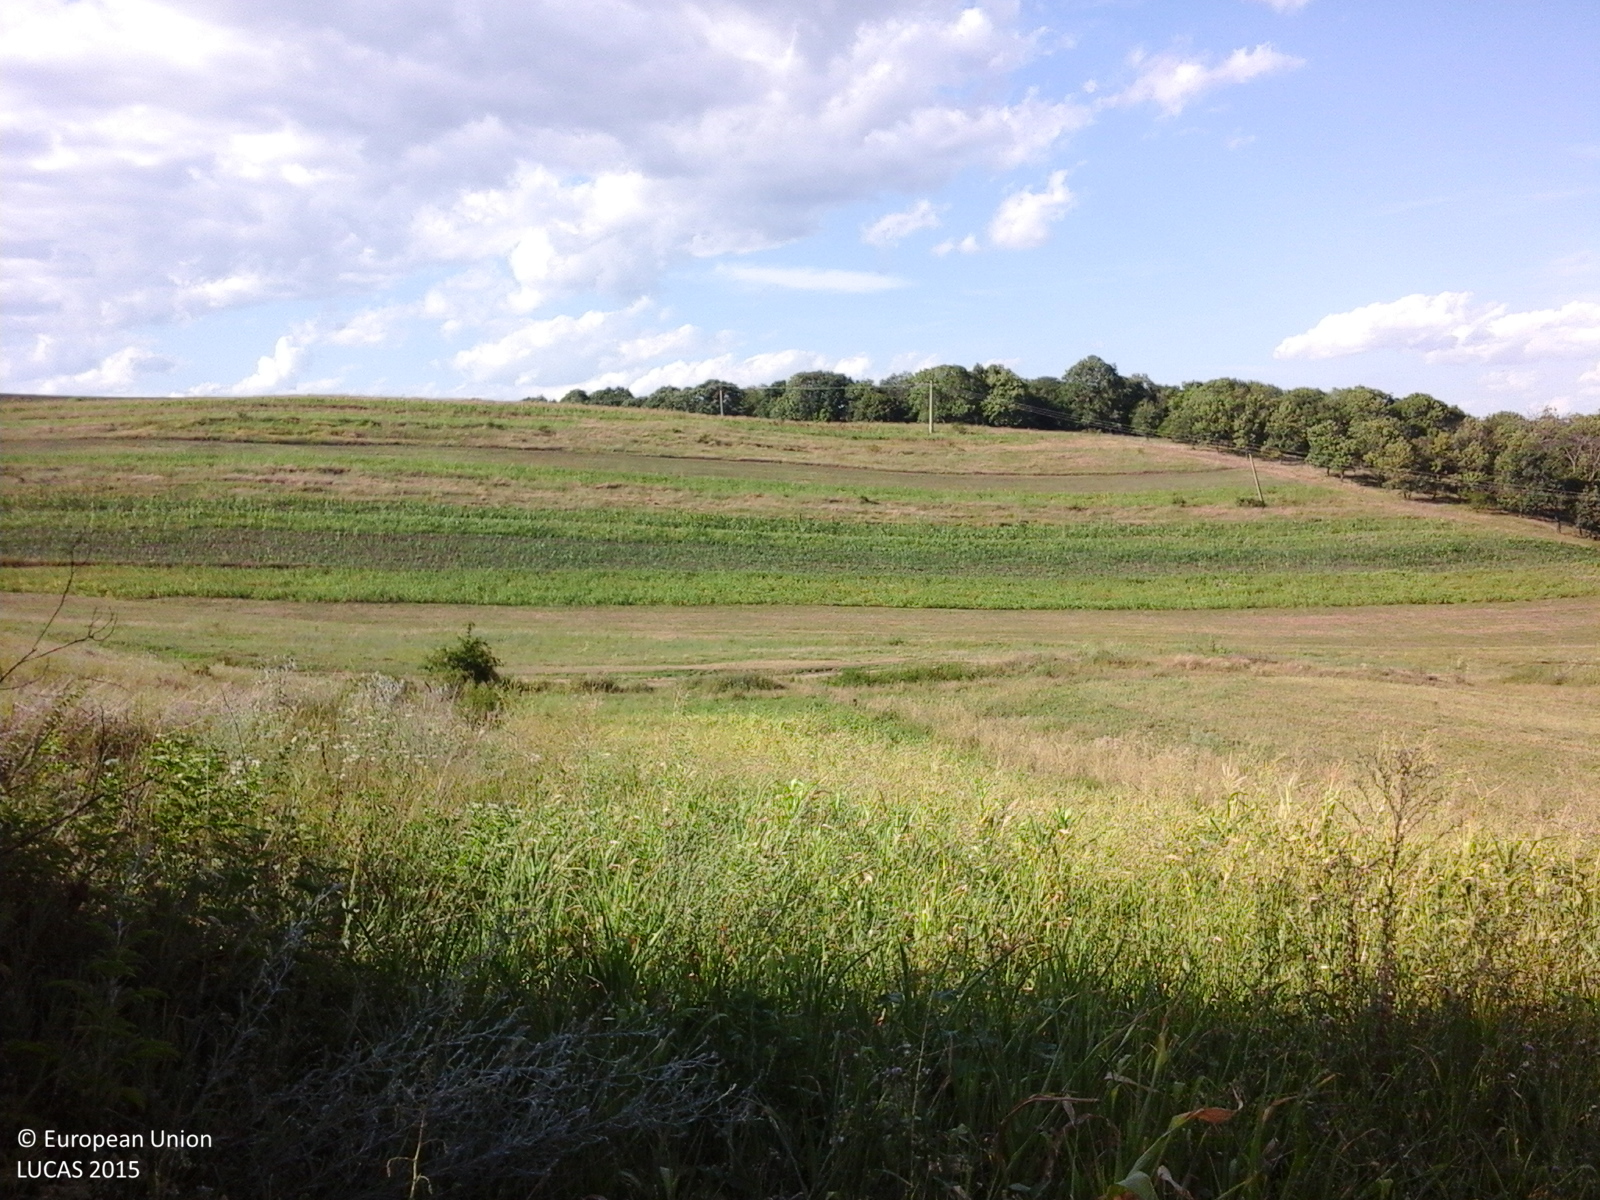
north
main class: Cropland
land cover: Maize
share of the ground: > 75 %
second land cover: Spontaneously vegetated surfaces
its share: > 75 %
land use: Agriculture (excluding fallow land and kitchen gardens)
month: July
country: RO
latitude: 46.0390
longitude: 27.6992
